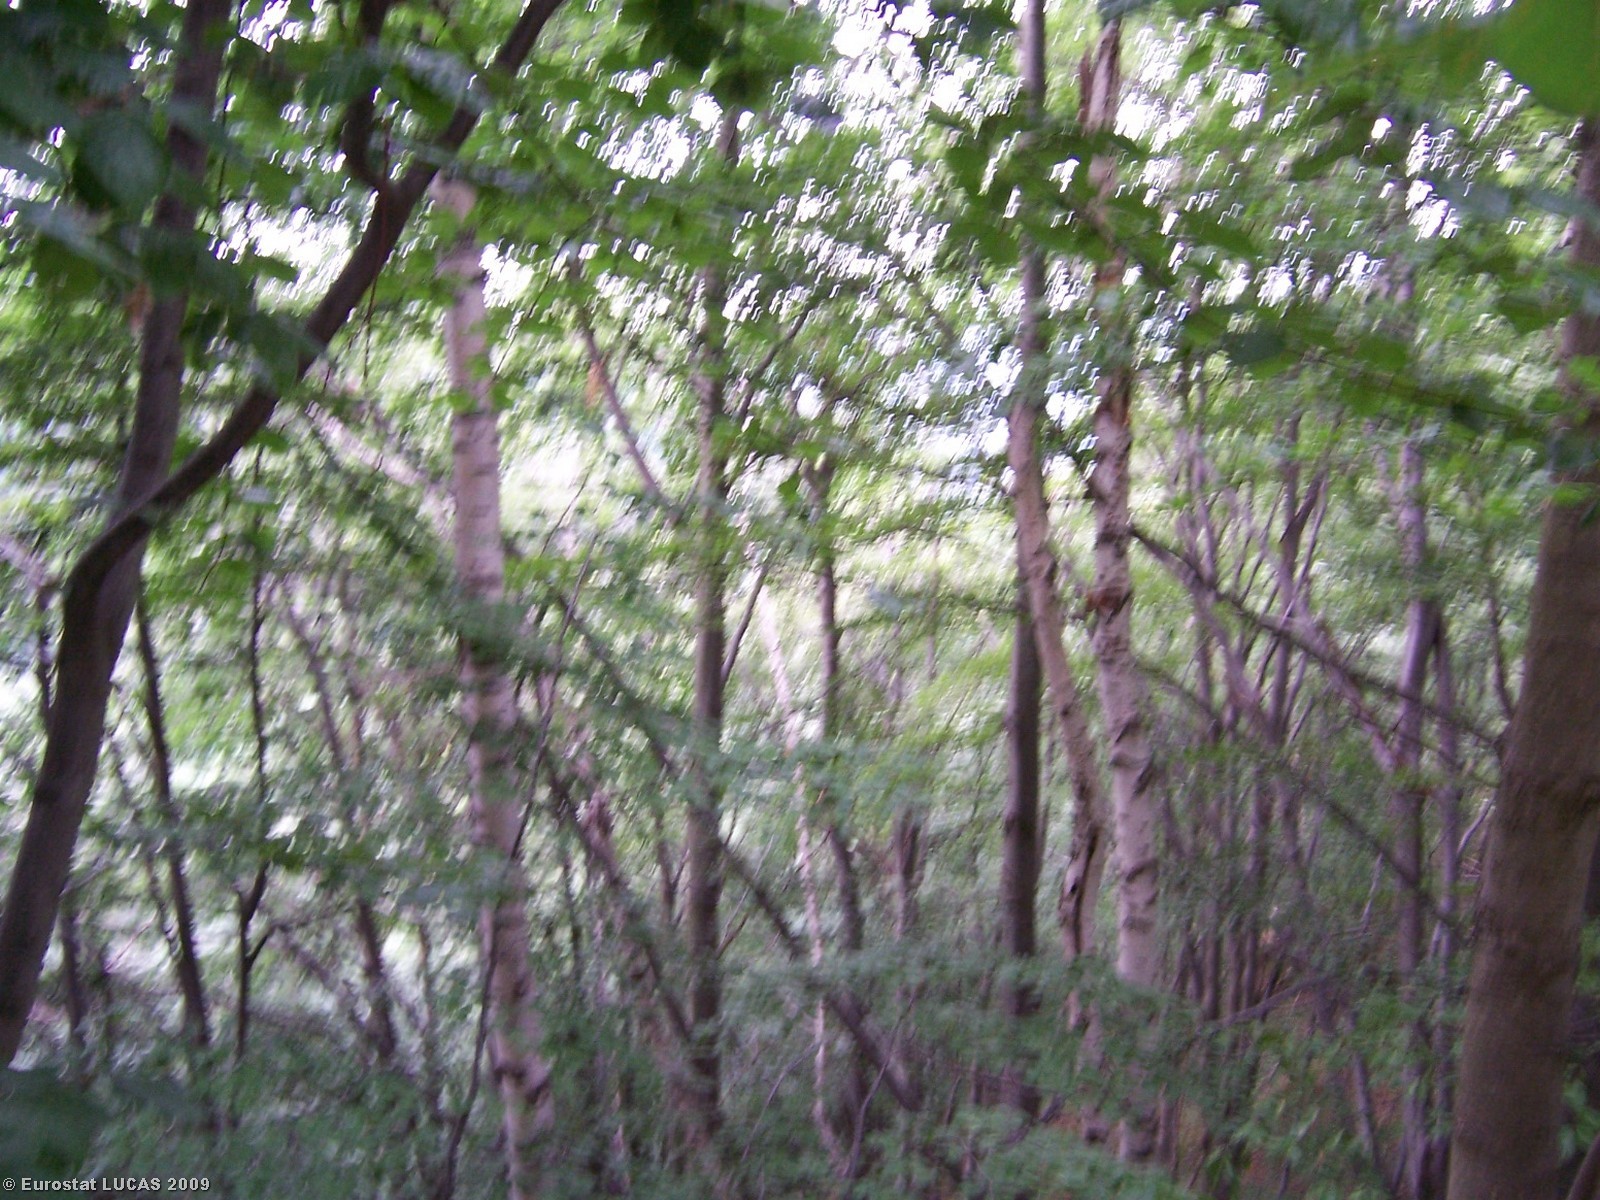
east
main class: Woodland
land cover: Broadleaved woodland
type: mountainous beech forest
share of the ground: > 75 %
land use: Unused
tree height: > 5 m
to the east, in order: Broadleaved woodland; Spontaneously vegetated surfaces; Broadleaved woodland
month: July
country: IT
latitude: 45.2012
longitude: 7.3691
